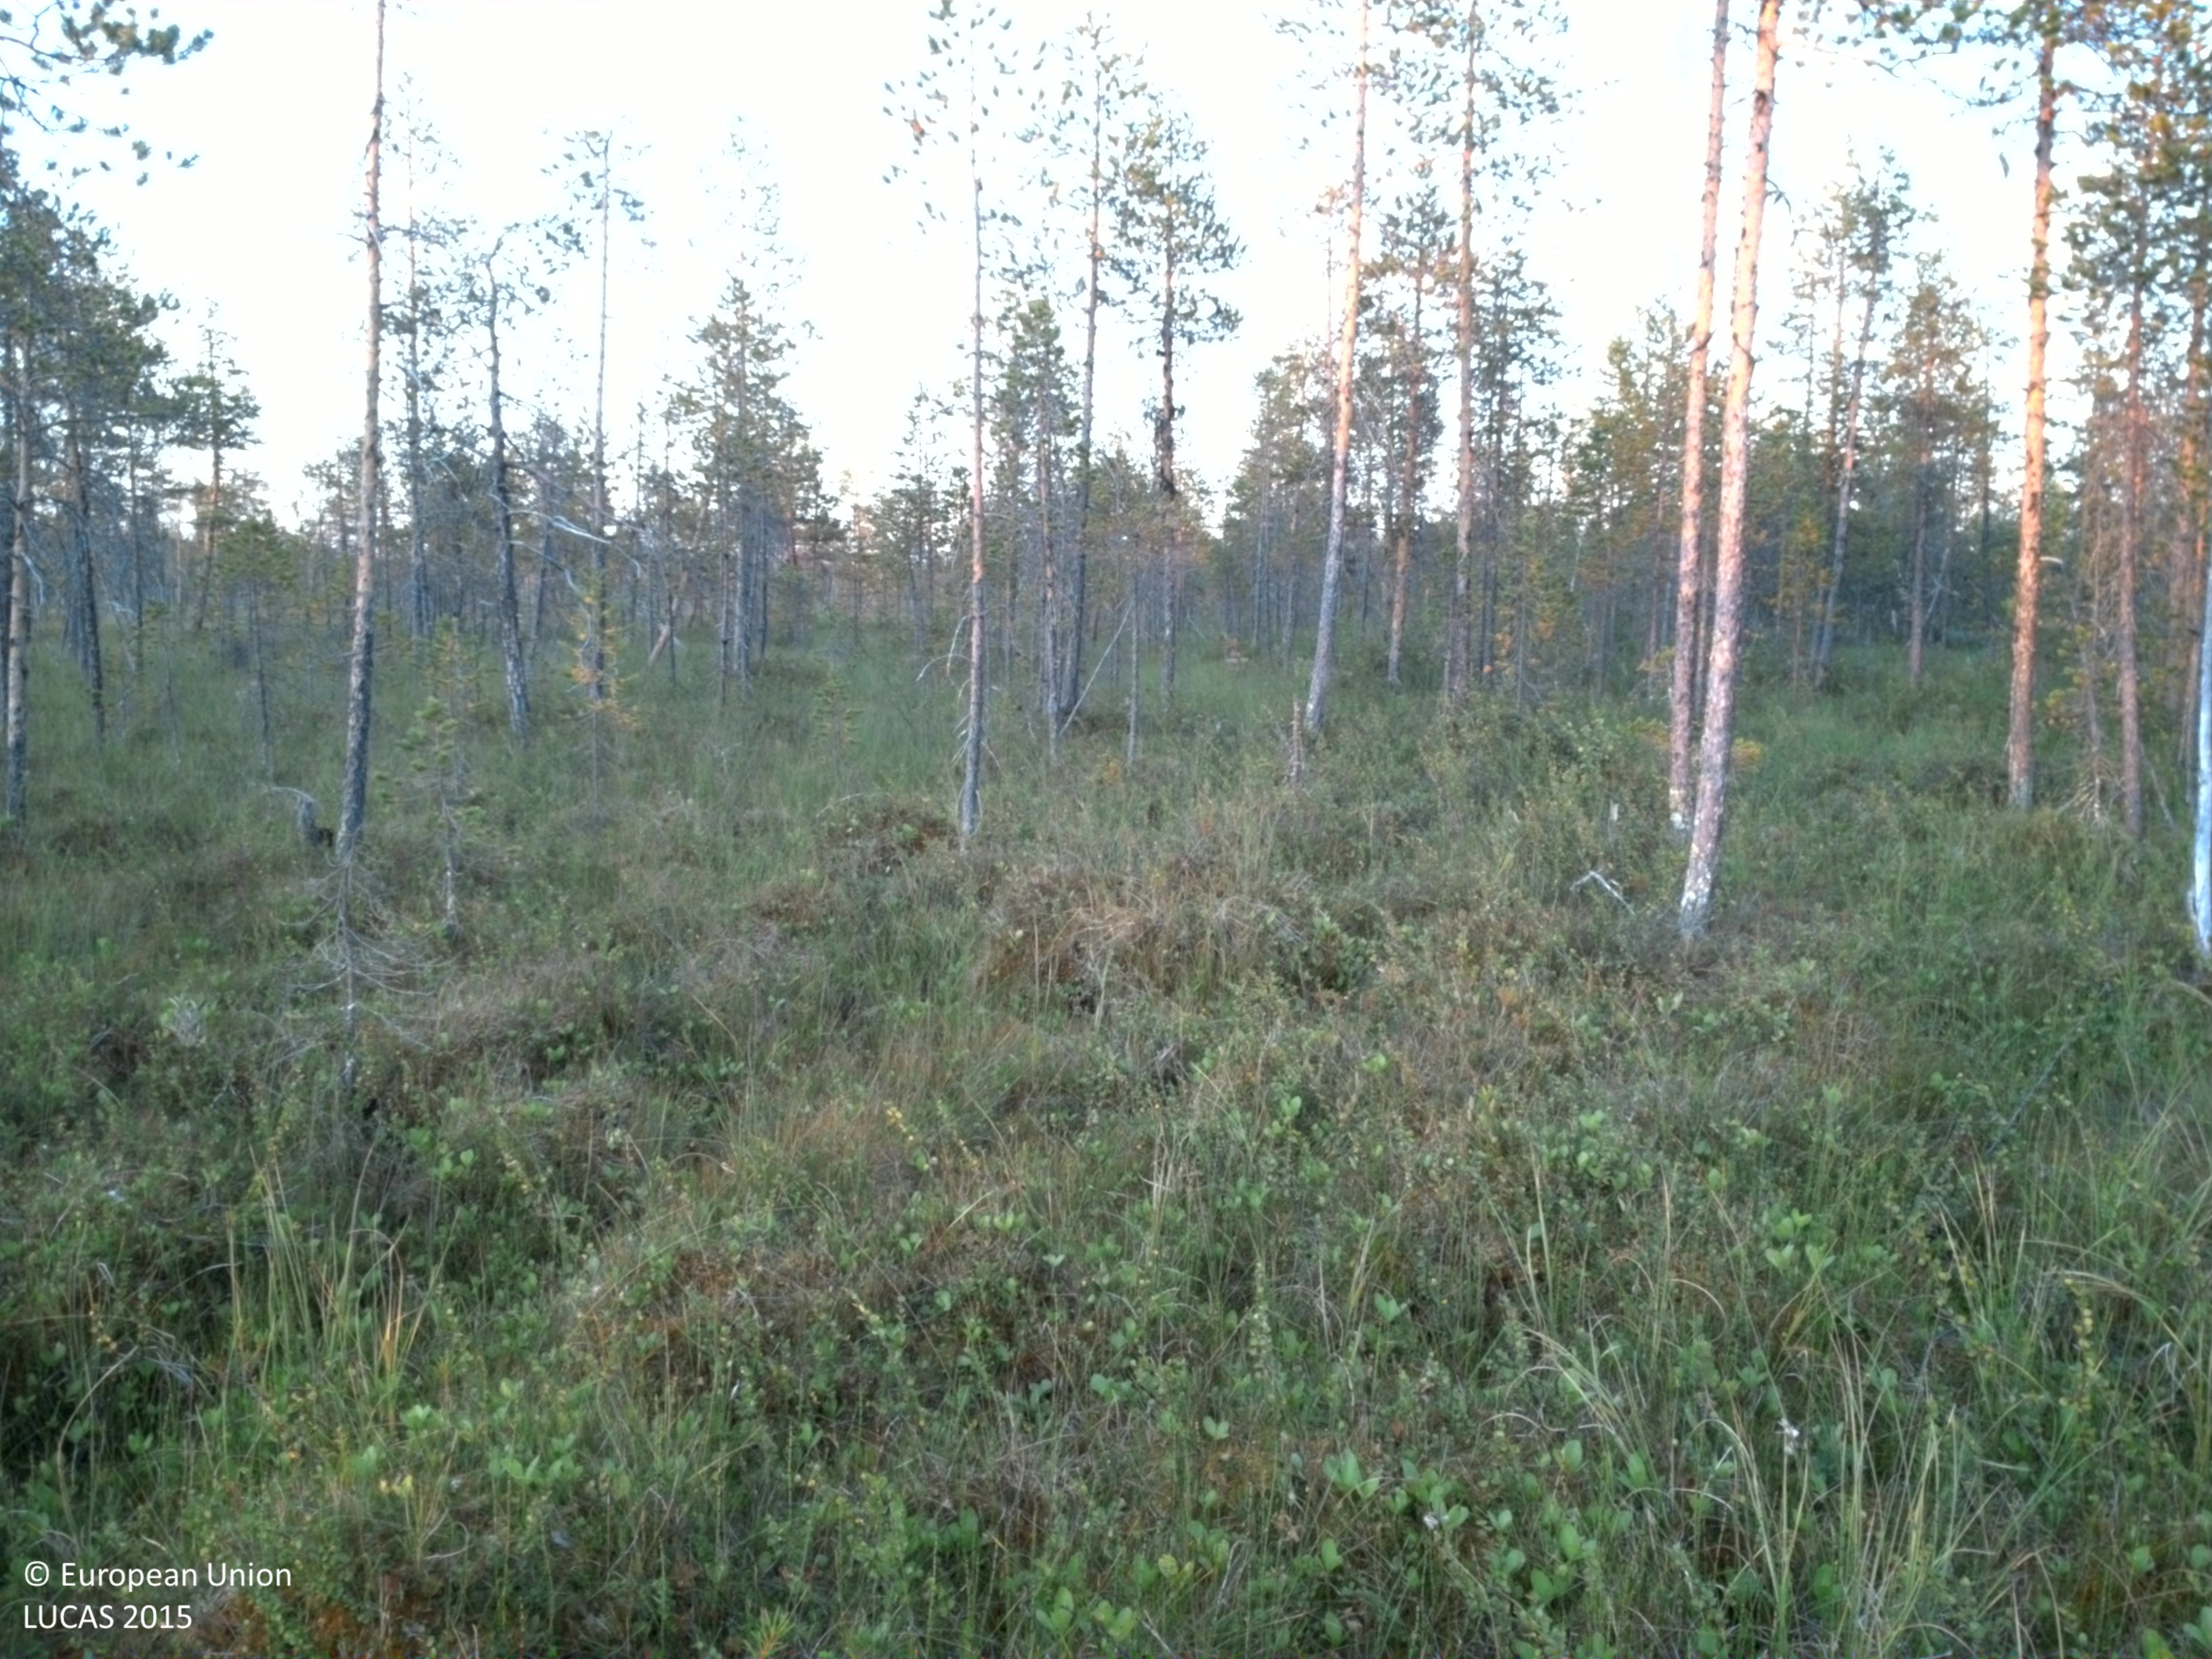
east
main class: Woodland
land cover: Pine dominated coniferous woodland
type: mire and swamp forests
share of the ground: 10 - 25 %
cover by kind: shrubs 55 %, coniferous forest trees 20 %, lichens and mosses 15 %, herbaceous plants 10 %
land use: Semi-natural and natural areas not in use
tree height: > 5 m
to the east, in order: Pine dominated coniferous woodland; Peatbogs; Pine dominated coniferous woodland; Peatbogs
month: August
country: SE
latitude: 66.6124
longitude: 19.1389
